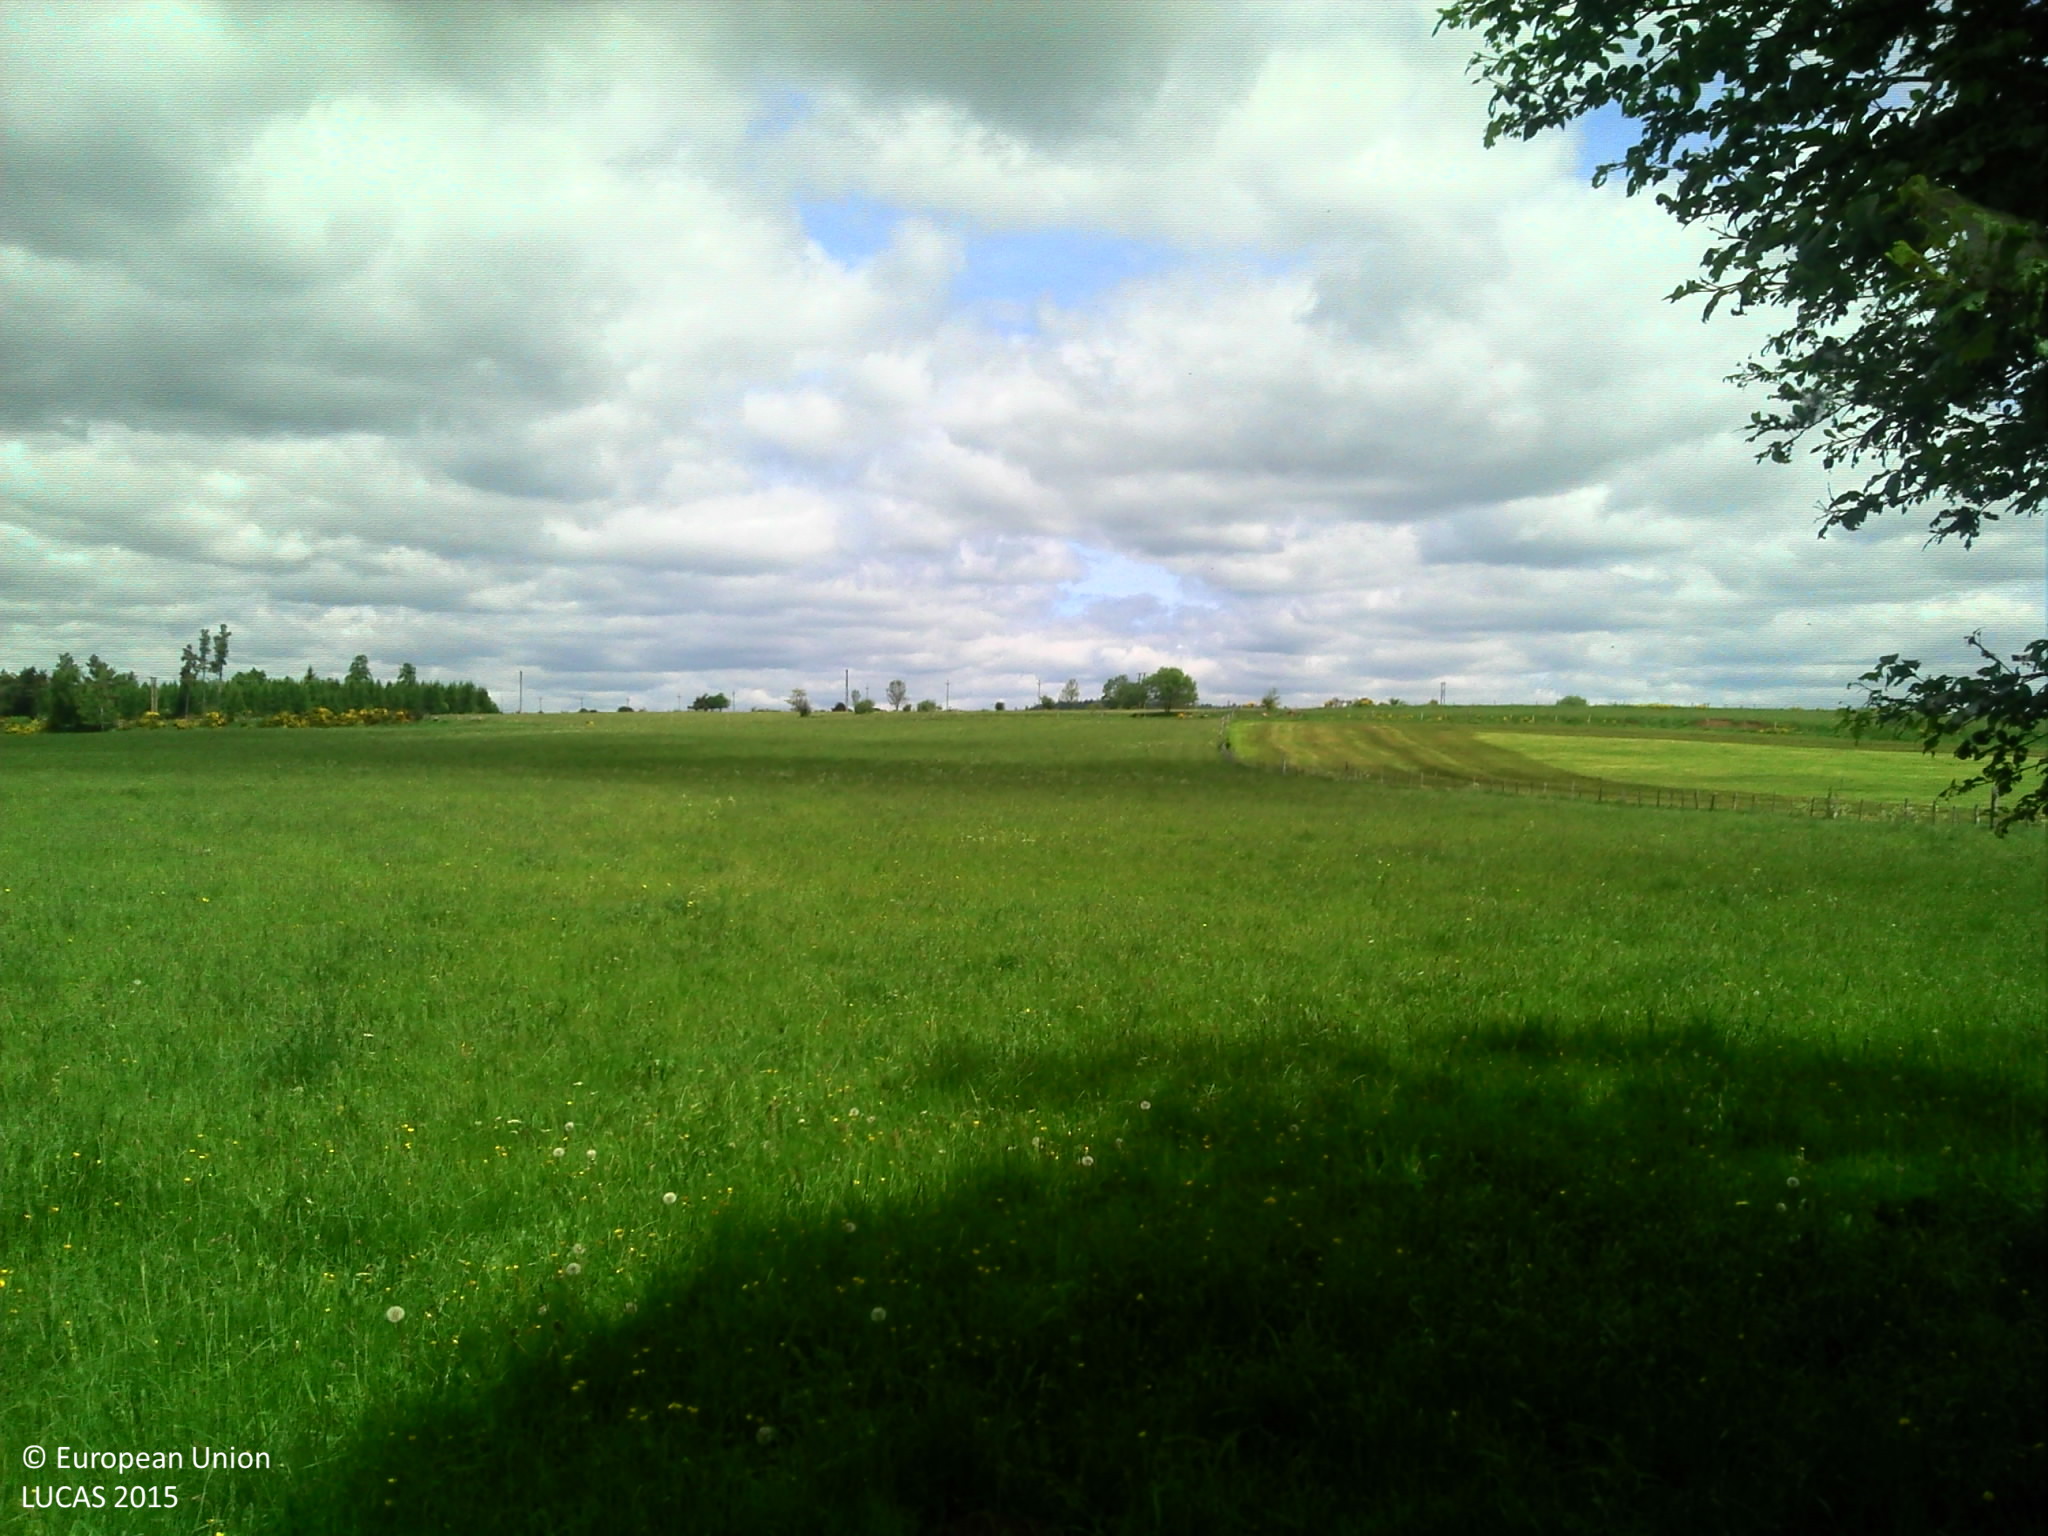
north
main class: Grassland
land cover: Grassland without tree/shrub cover
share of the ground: > 75 %
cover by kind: herbaceous plants 100 %
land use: Agriculture (excluding fallow land and kitchen gardens)
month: May
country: FR
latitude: 44.9750
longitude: 2.8882
